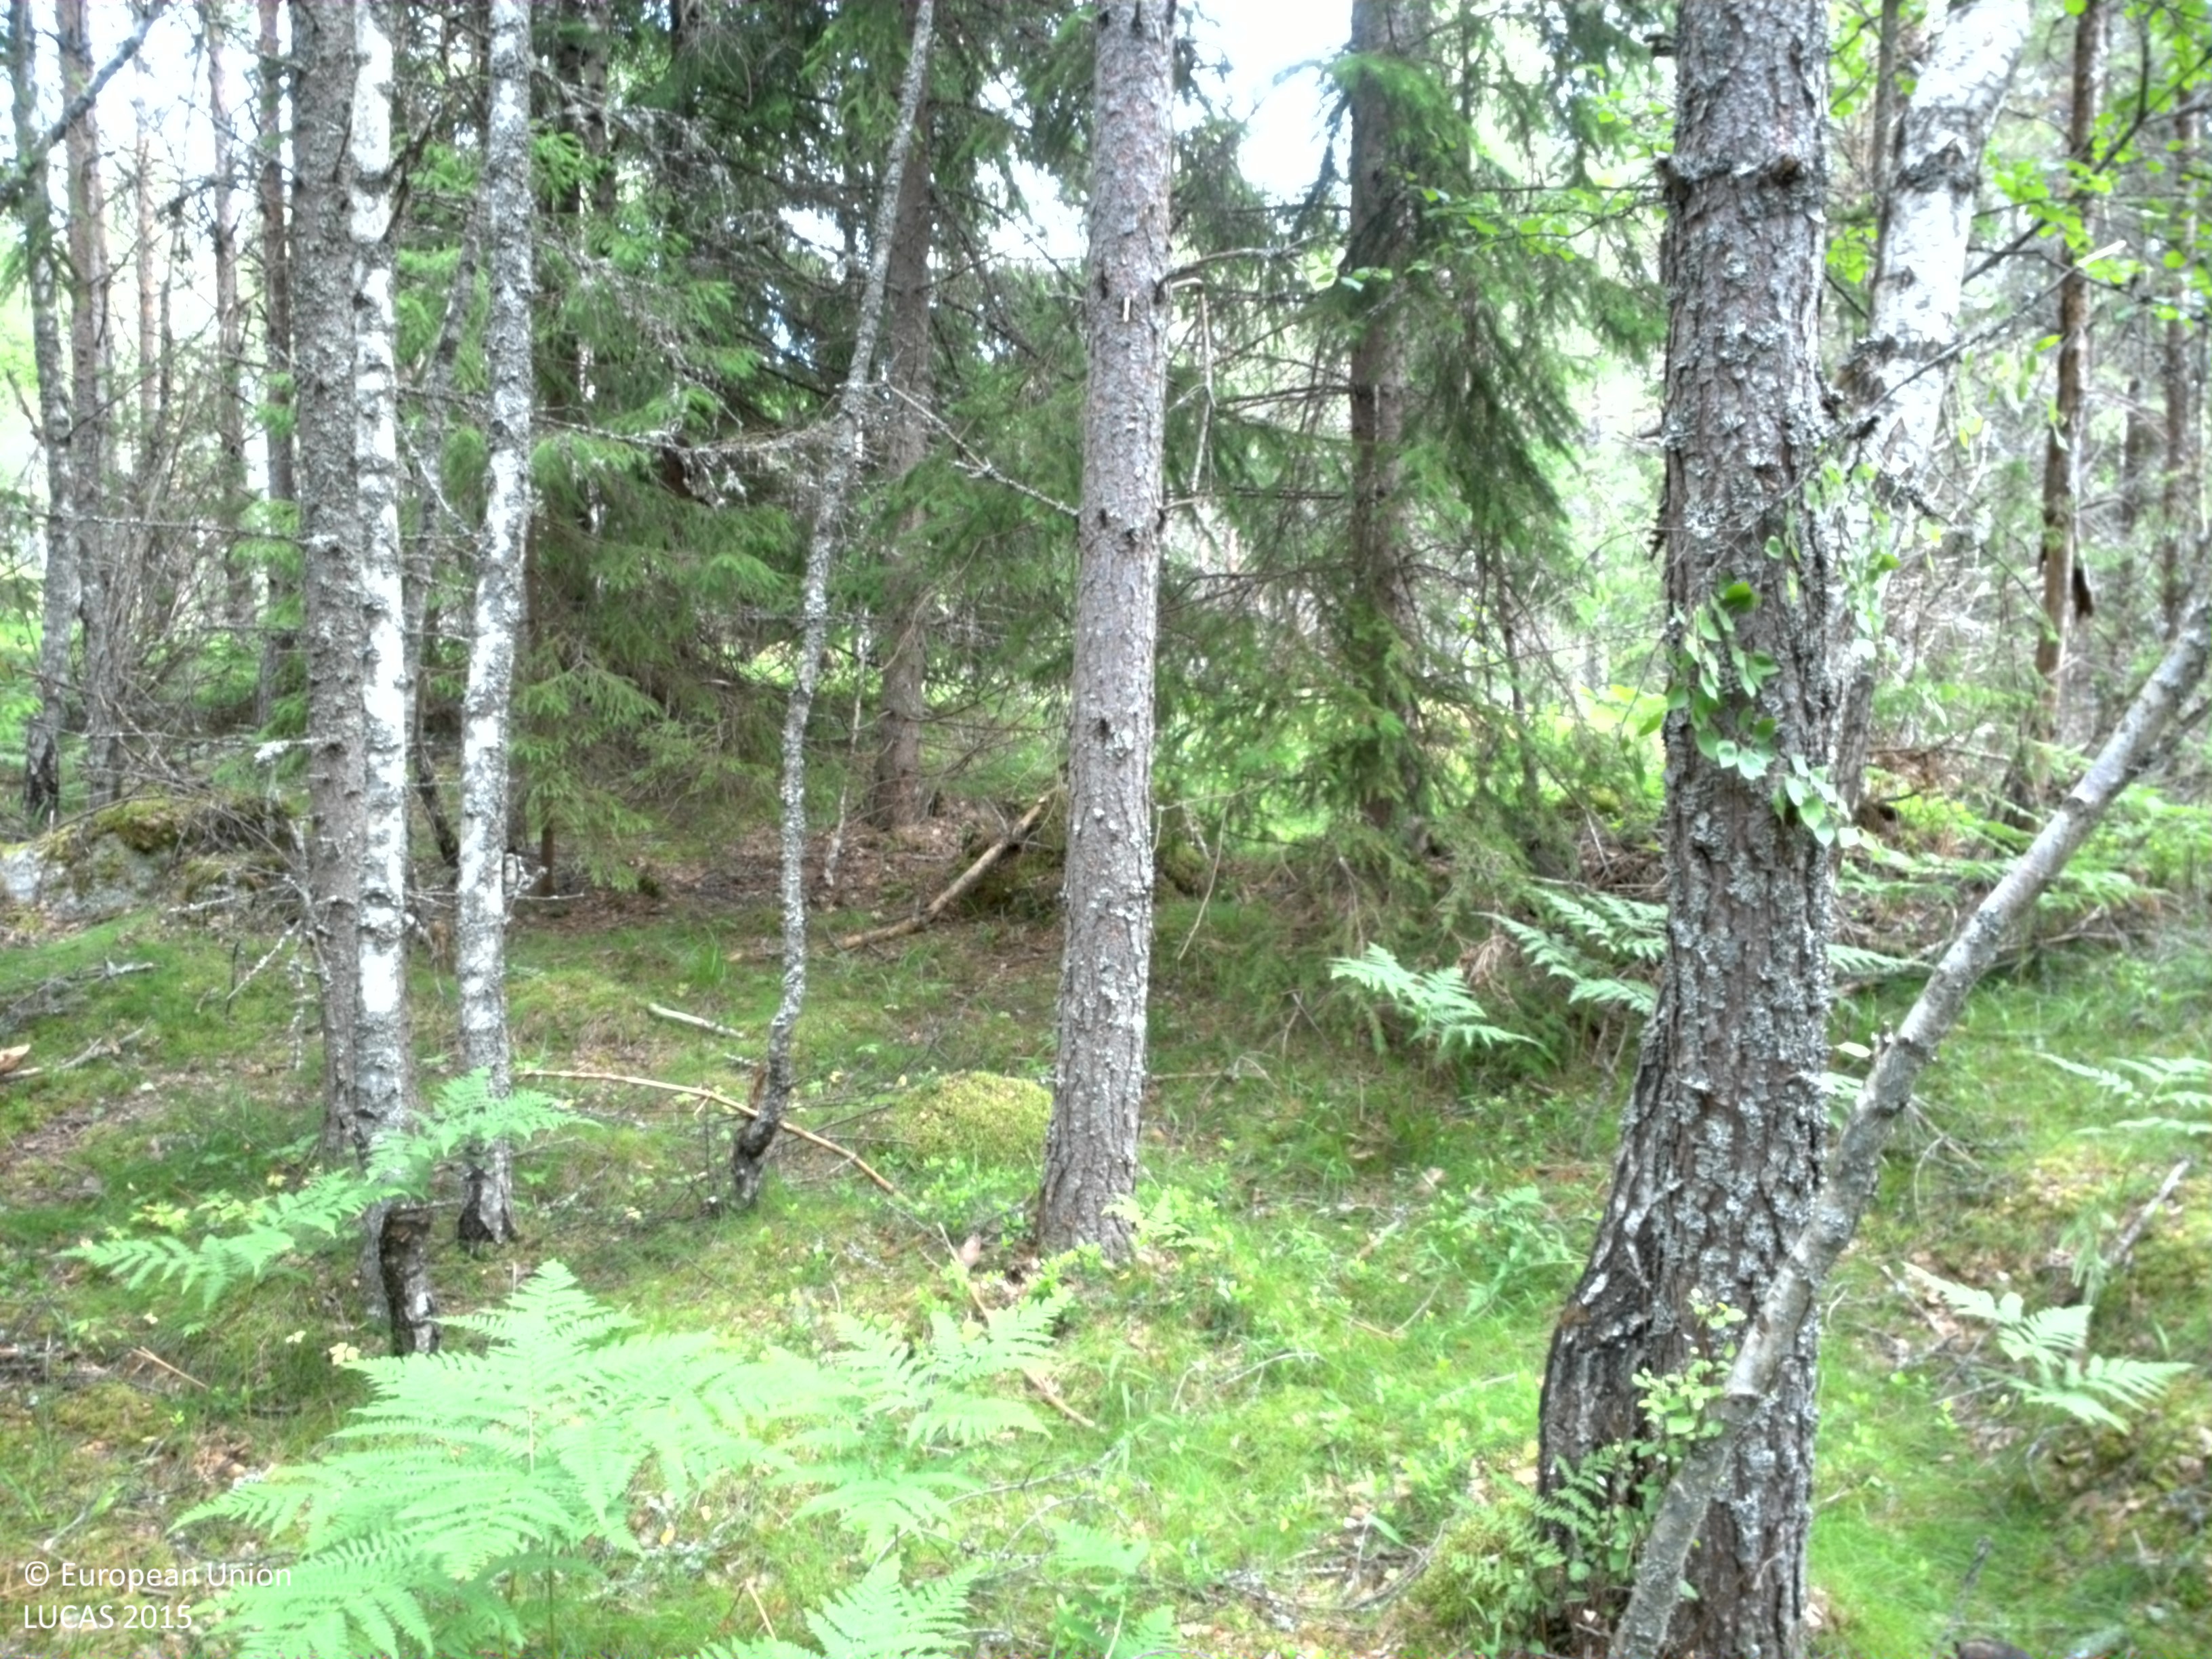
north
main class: Woodland
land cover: Pine dominated mixed woodland
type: boreal forest
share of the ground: 25 - 50 %
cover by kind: herbaceous plants 45 %, coniferous forest trees 25 %, lichens and mosses 20 %, broadleaved forest trees 10 %
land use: Forestry
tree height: > 5 m
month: June
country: SE
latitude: 58.6291
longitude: 15.5222
